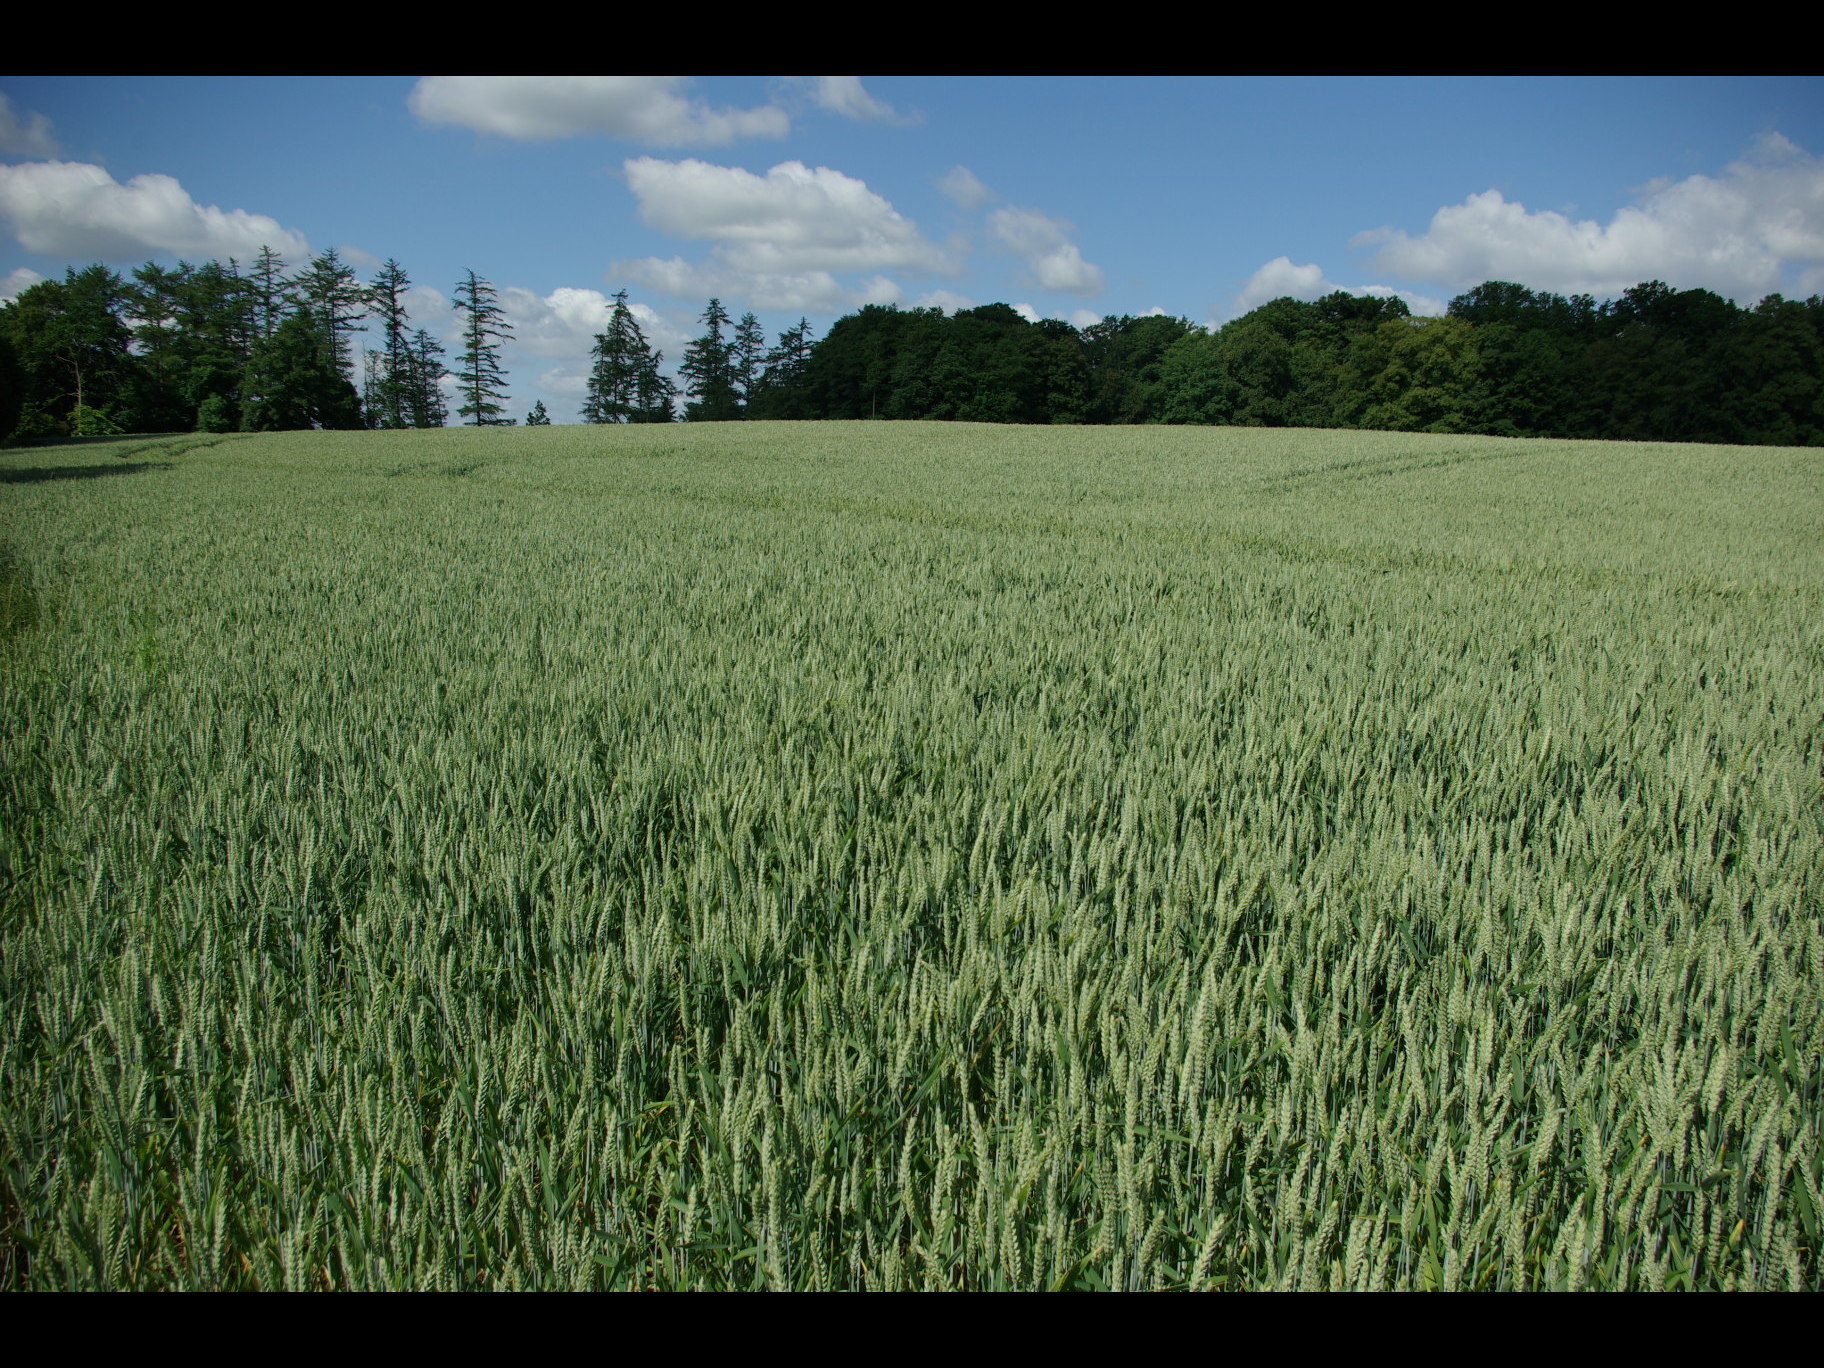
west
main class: Cropland
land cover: Common wheat
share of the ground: > 75 %
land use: Agriculture (excluding fallow land and kitchen gardens)
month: June
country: DE
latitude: 54.3724
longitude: 9.8923
